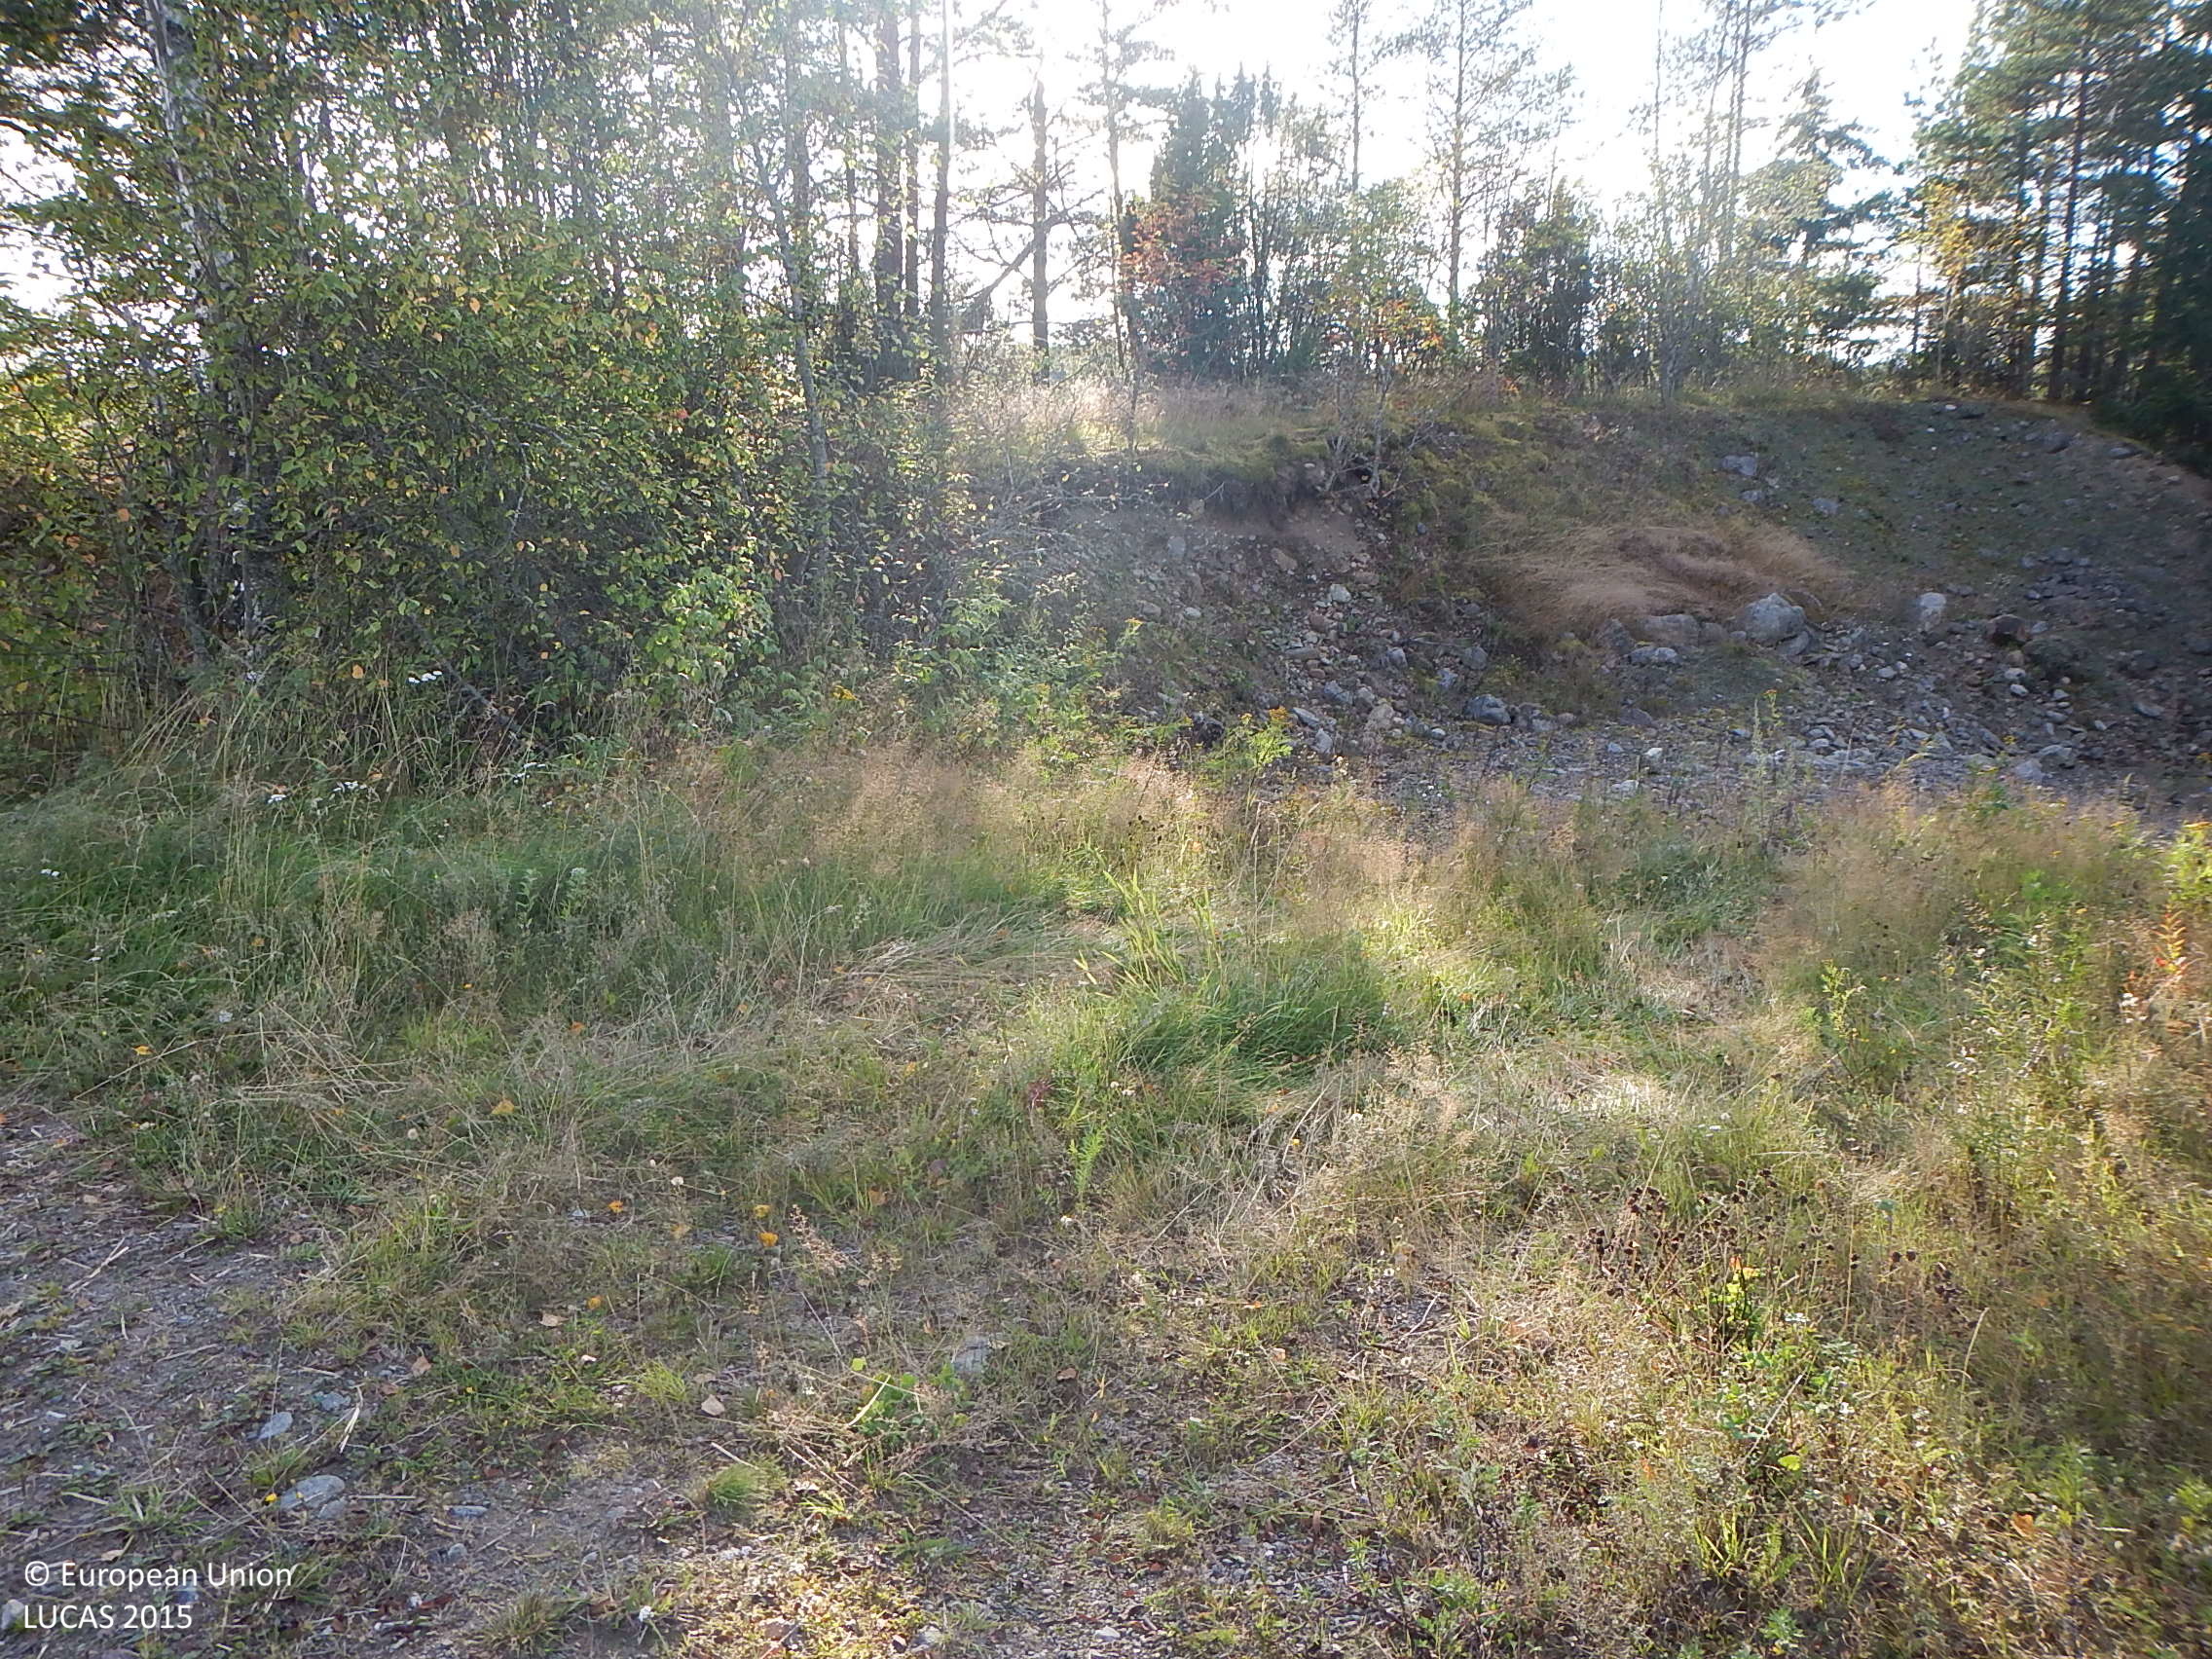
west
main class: Grassland
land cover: Spontaneously vegetated surfaces
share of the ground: > 75 %
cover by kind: herbaceous plants 100 %
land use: Fallow land
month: September
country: FI
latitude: 61.5011
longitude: 22.1006
